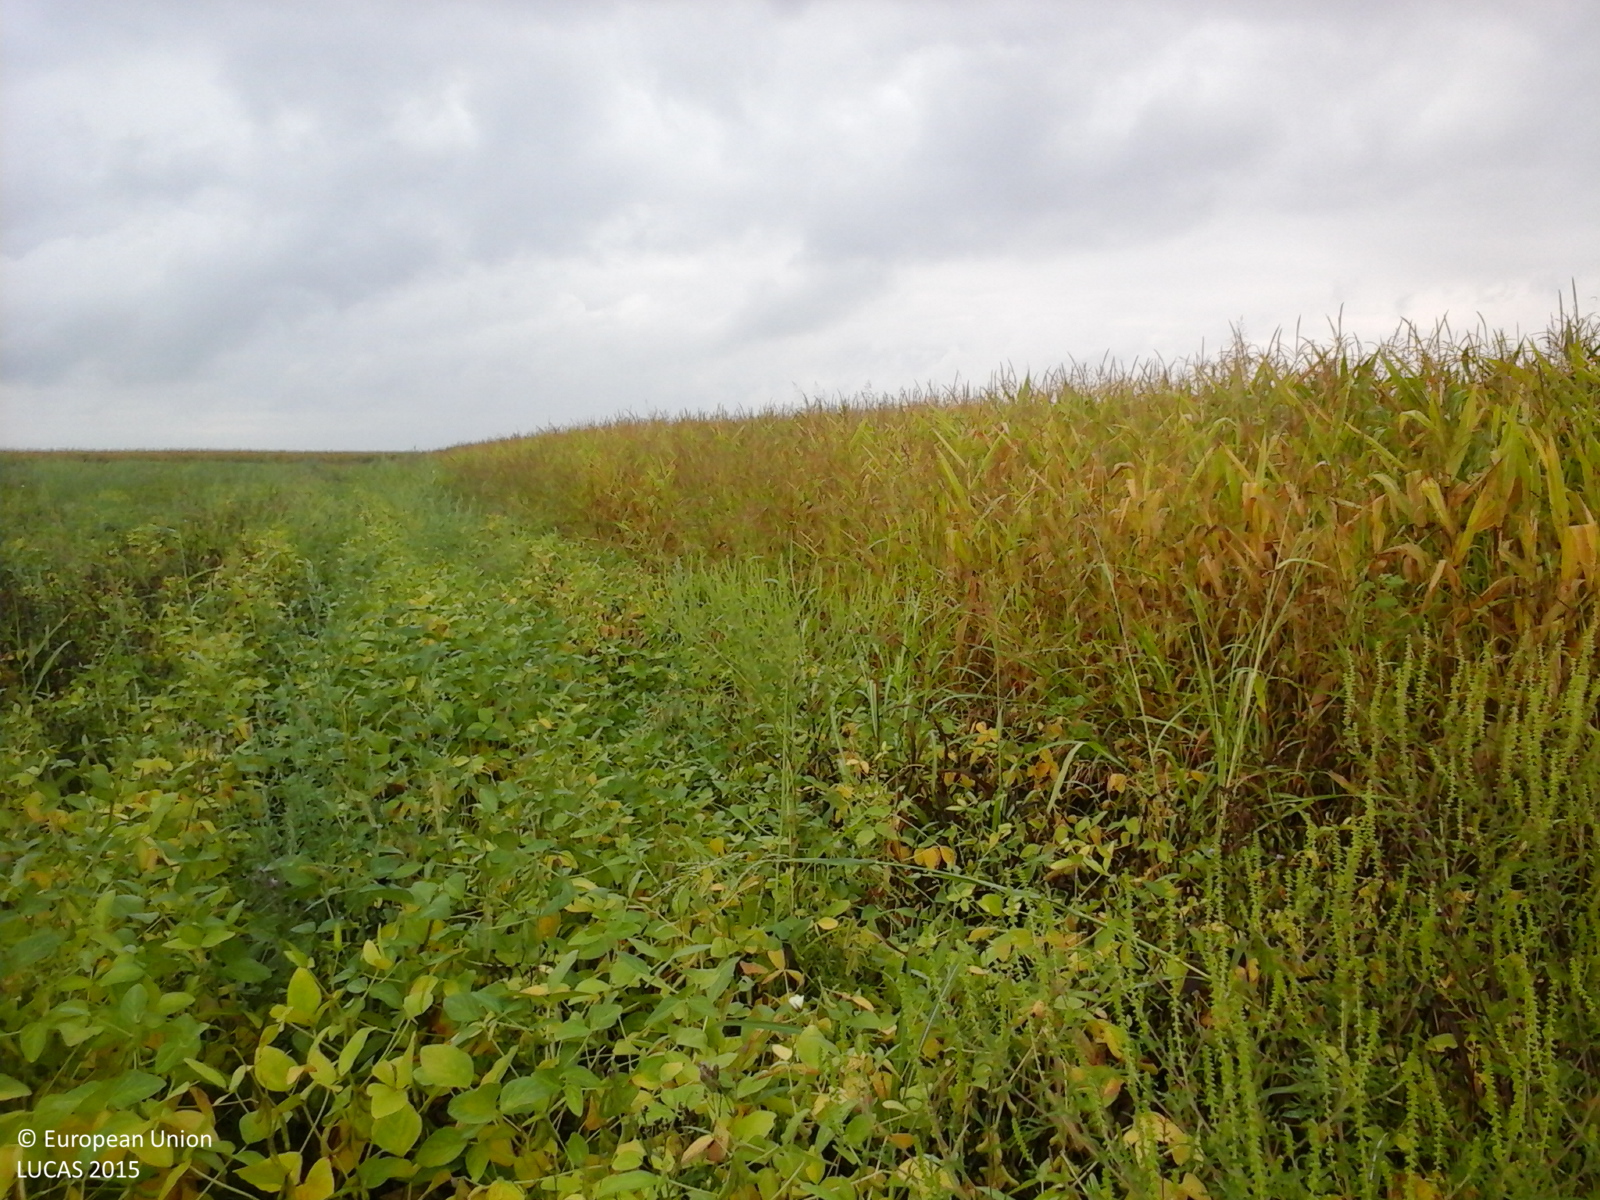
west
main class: Cropland
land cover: Maize
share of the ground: > 75 %
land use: Agriculture (excluding fallow land and kitchen gardens)
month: August
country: RO
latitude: 45.9356
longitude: 20.7441
